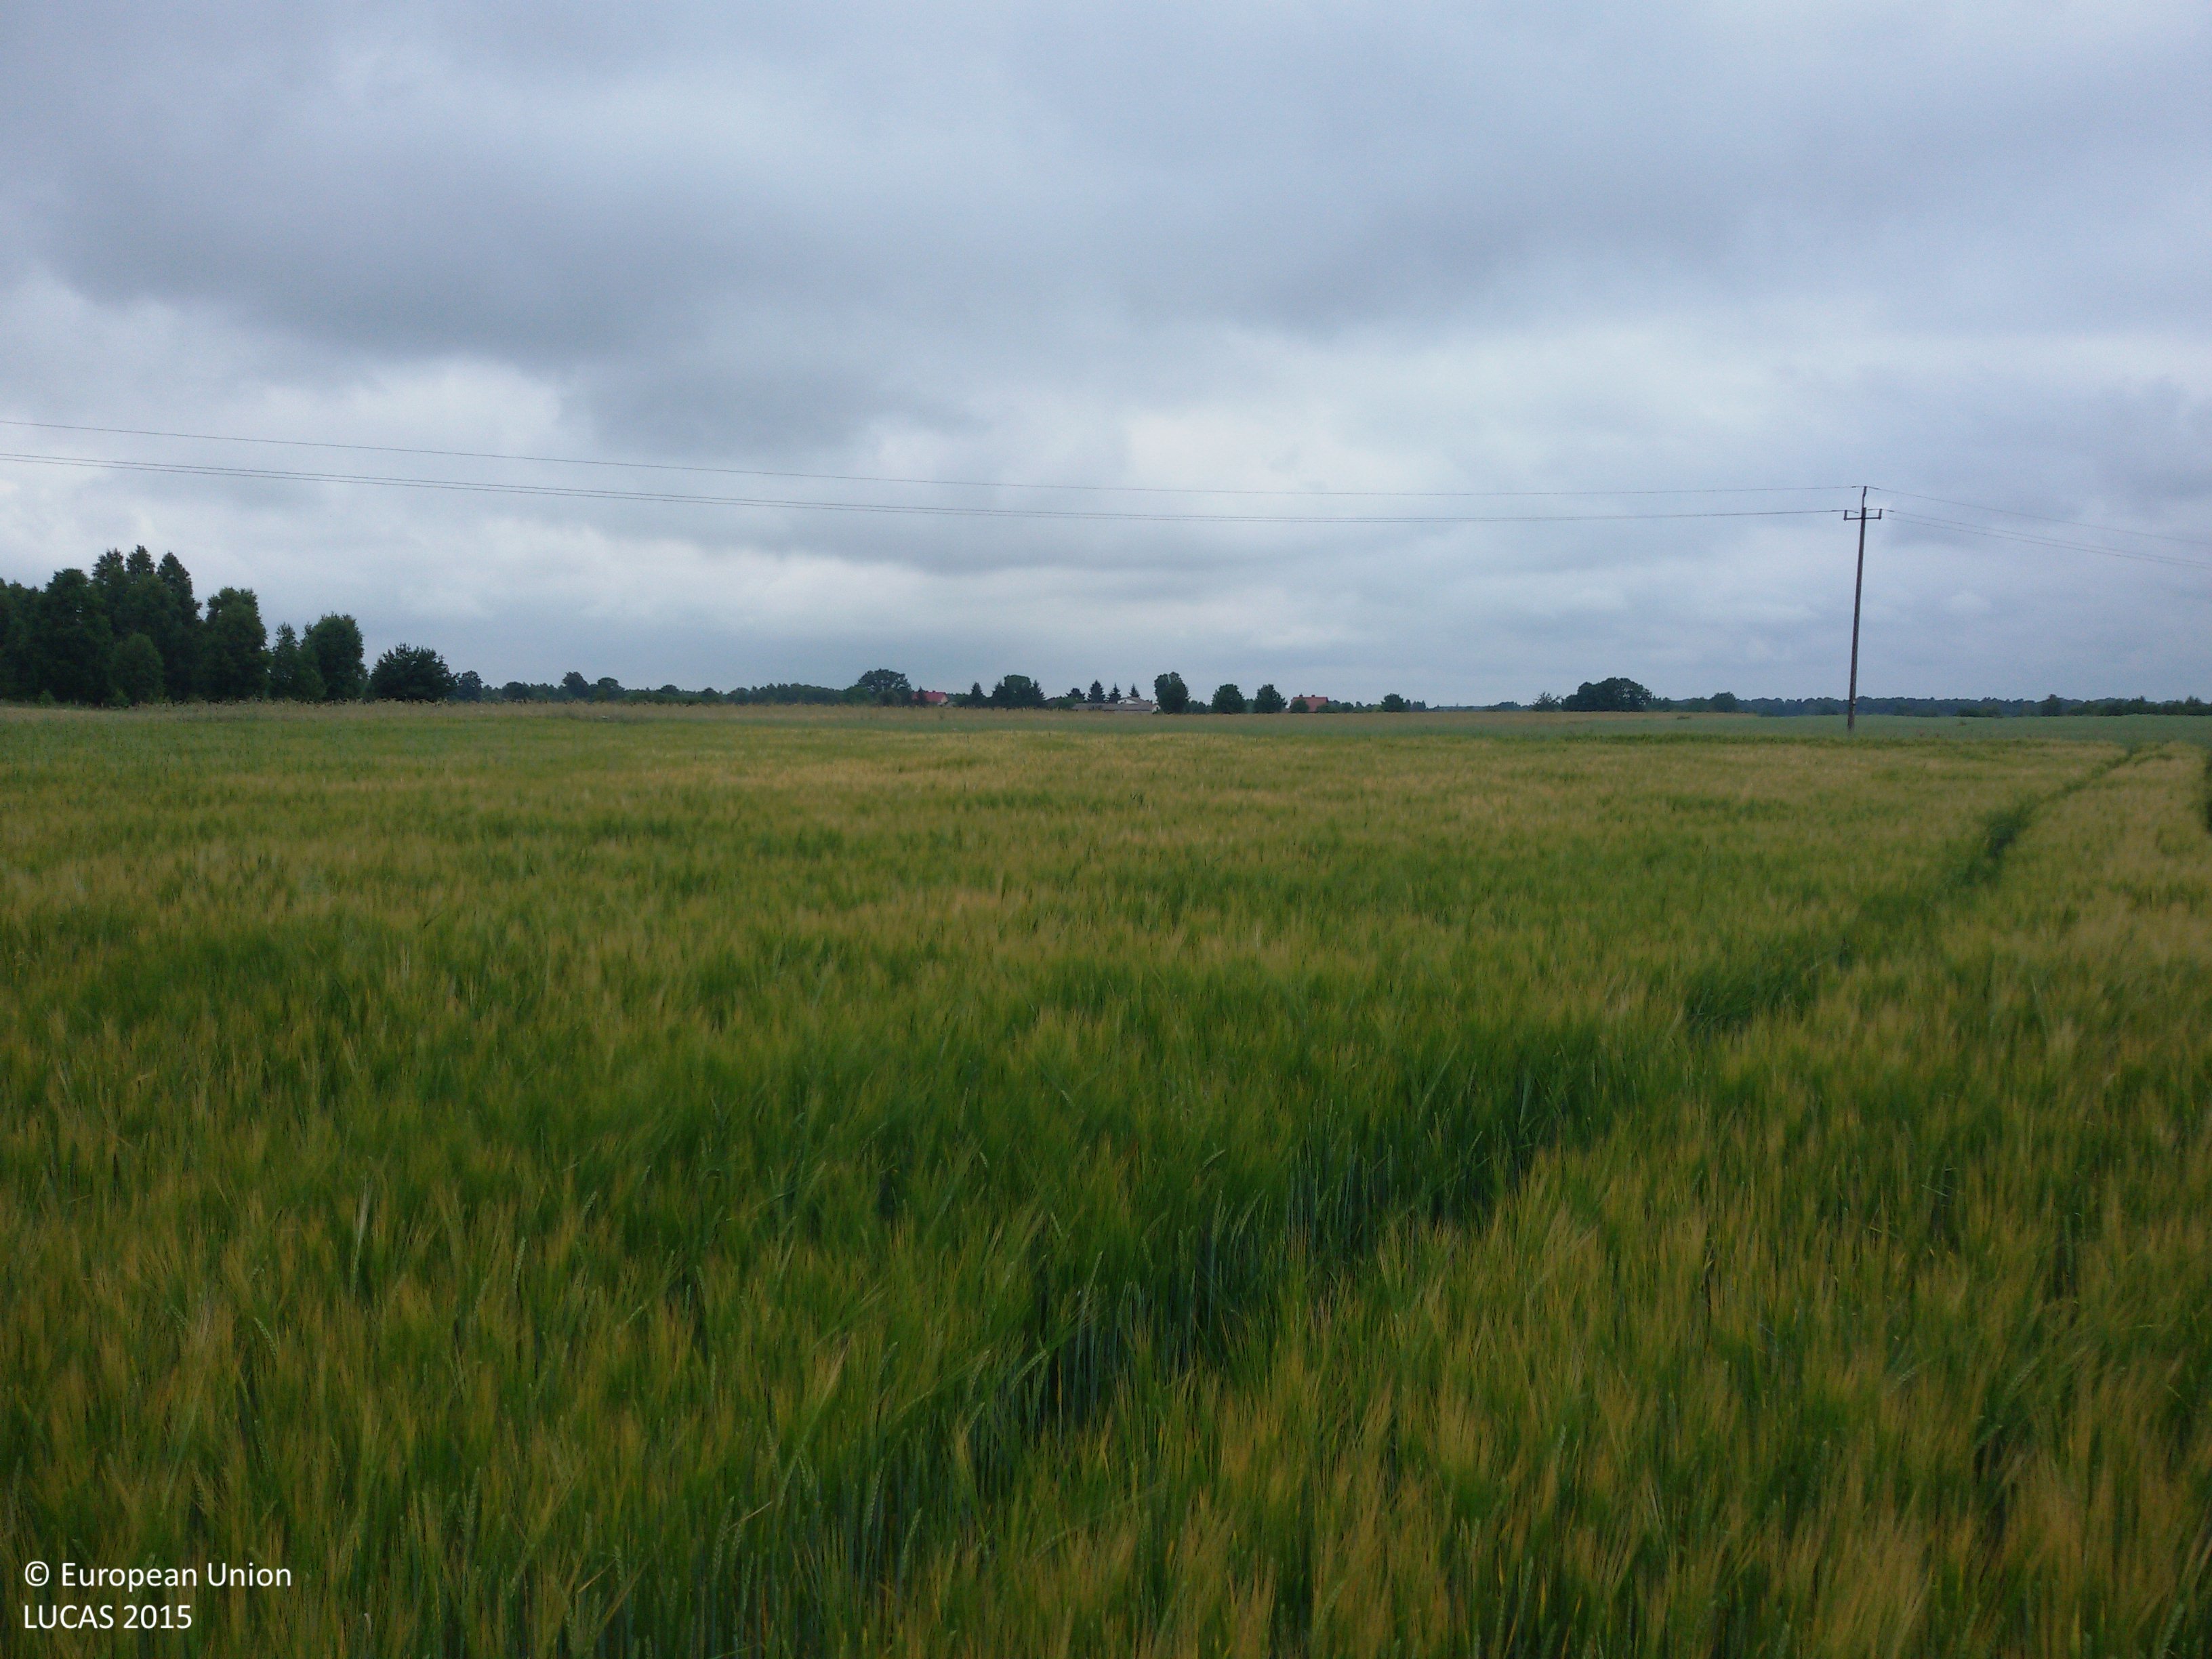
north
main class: Cropland
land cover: Barley
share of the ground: > 75 %
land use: Agriculture (excluding fallow land and kitchen gardens)
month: June
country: PL
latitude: 51.3749
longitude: 22.9315
